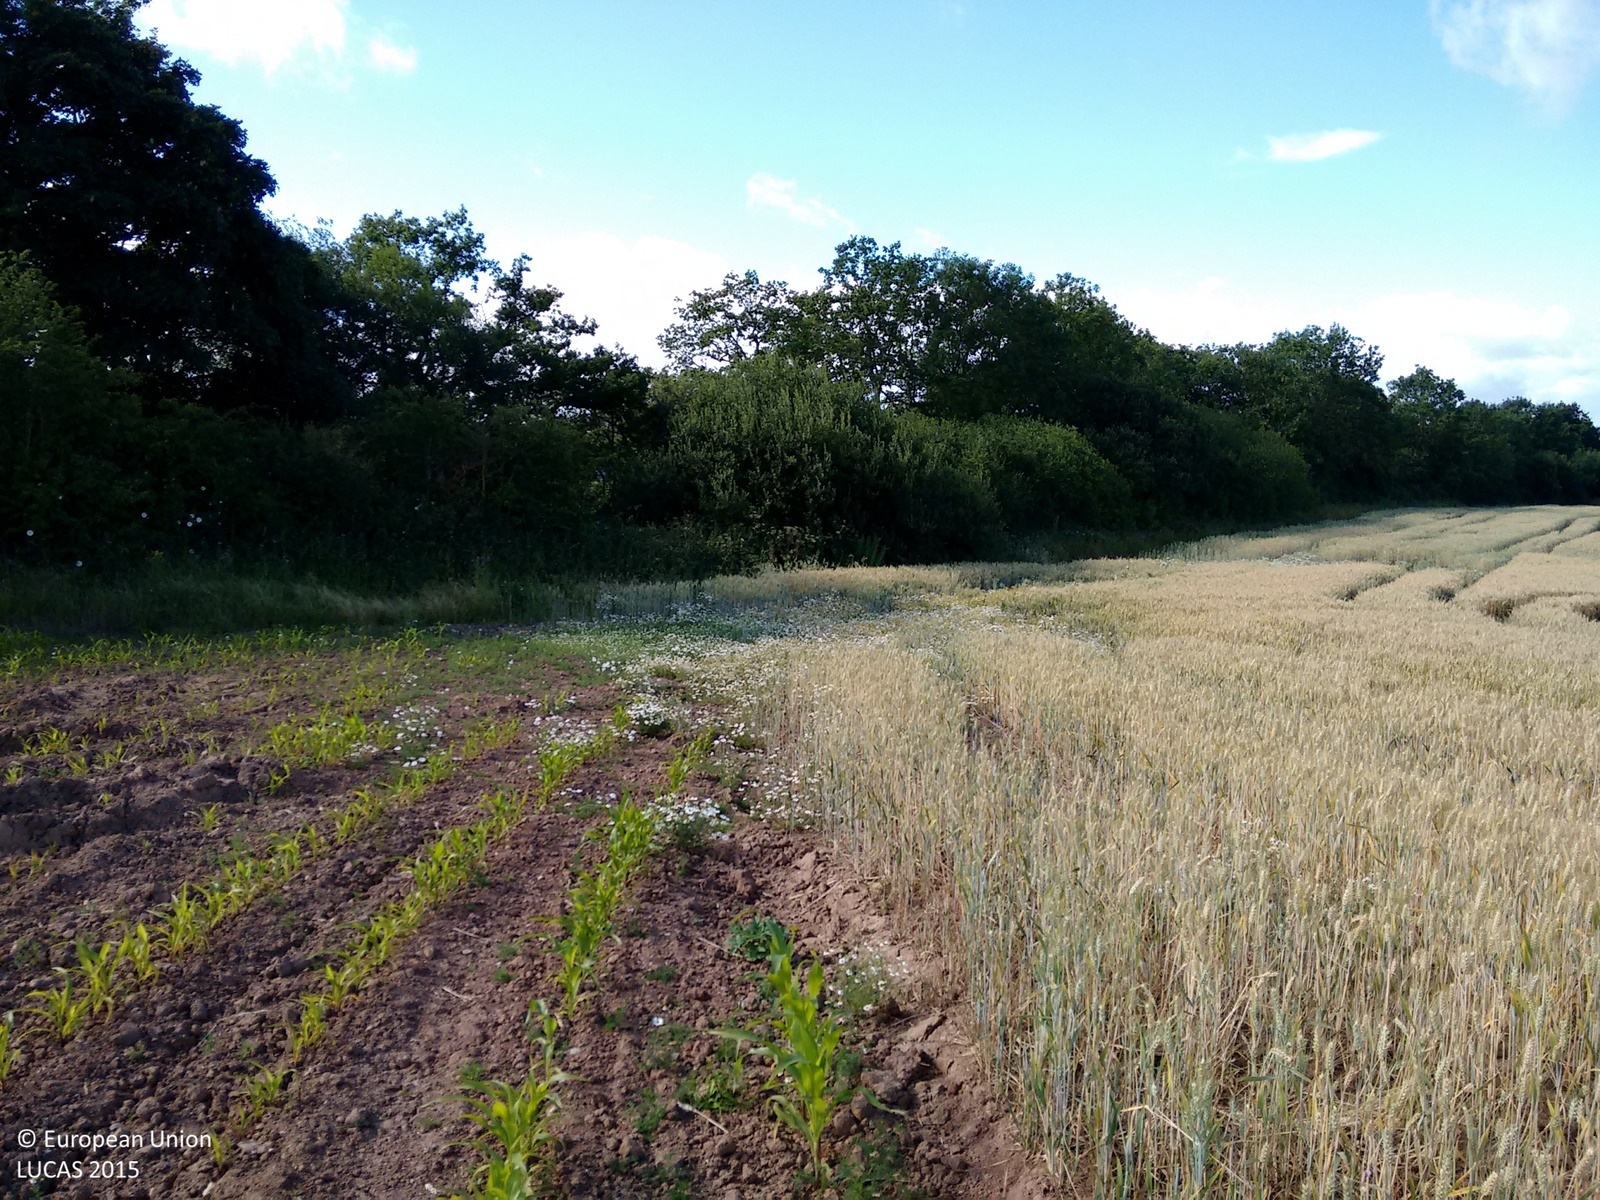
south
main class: Cropland
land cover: Common wheat
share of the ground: > 75 %
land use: Agriculture (excluding fallow land and kitchen gardens)
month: July
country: GB
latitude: 53.2189
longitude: -2.7247
